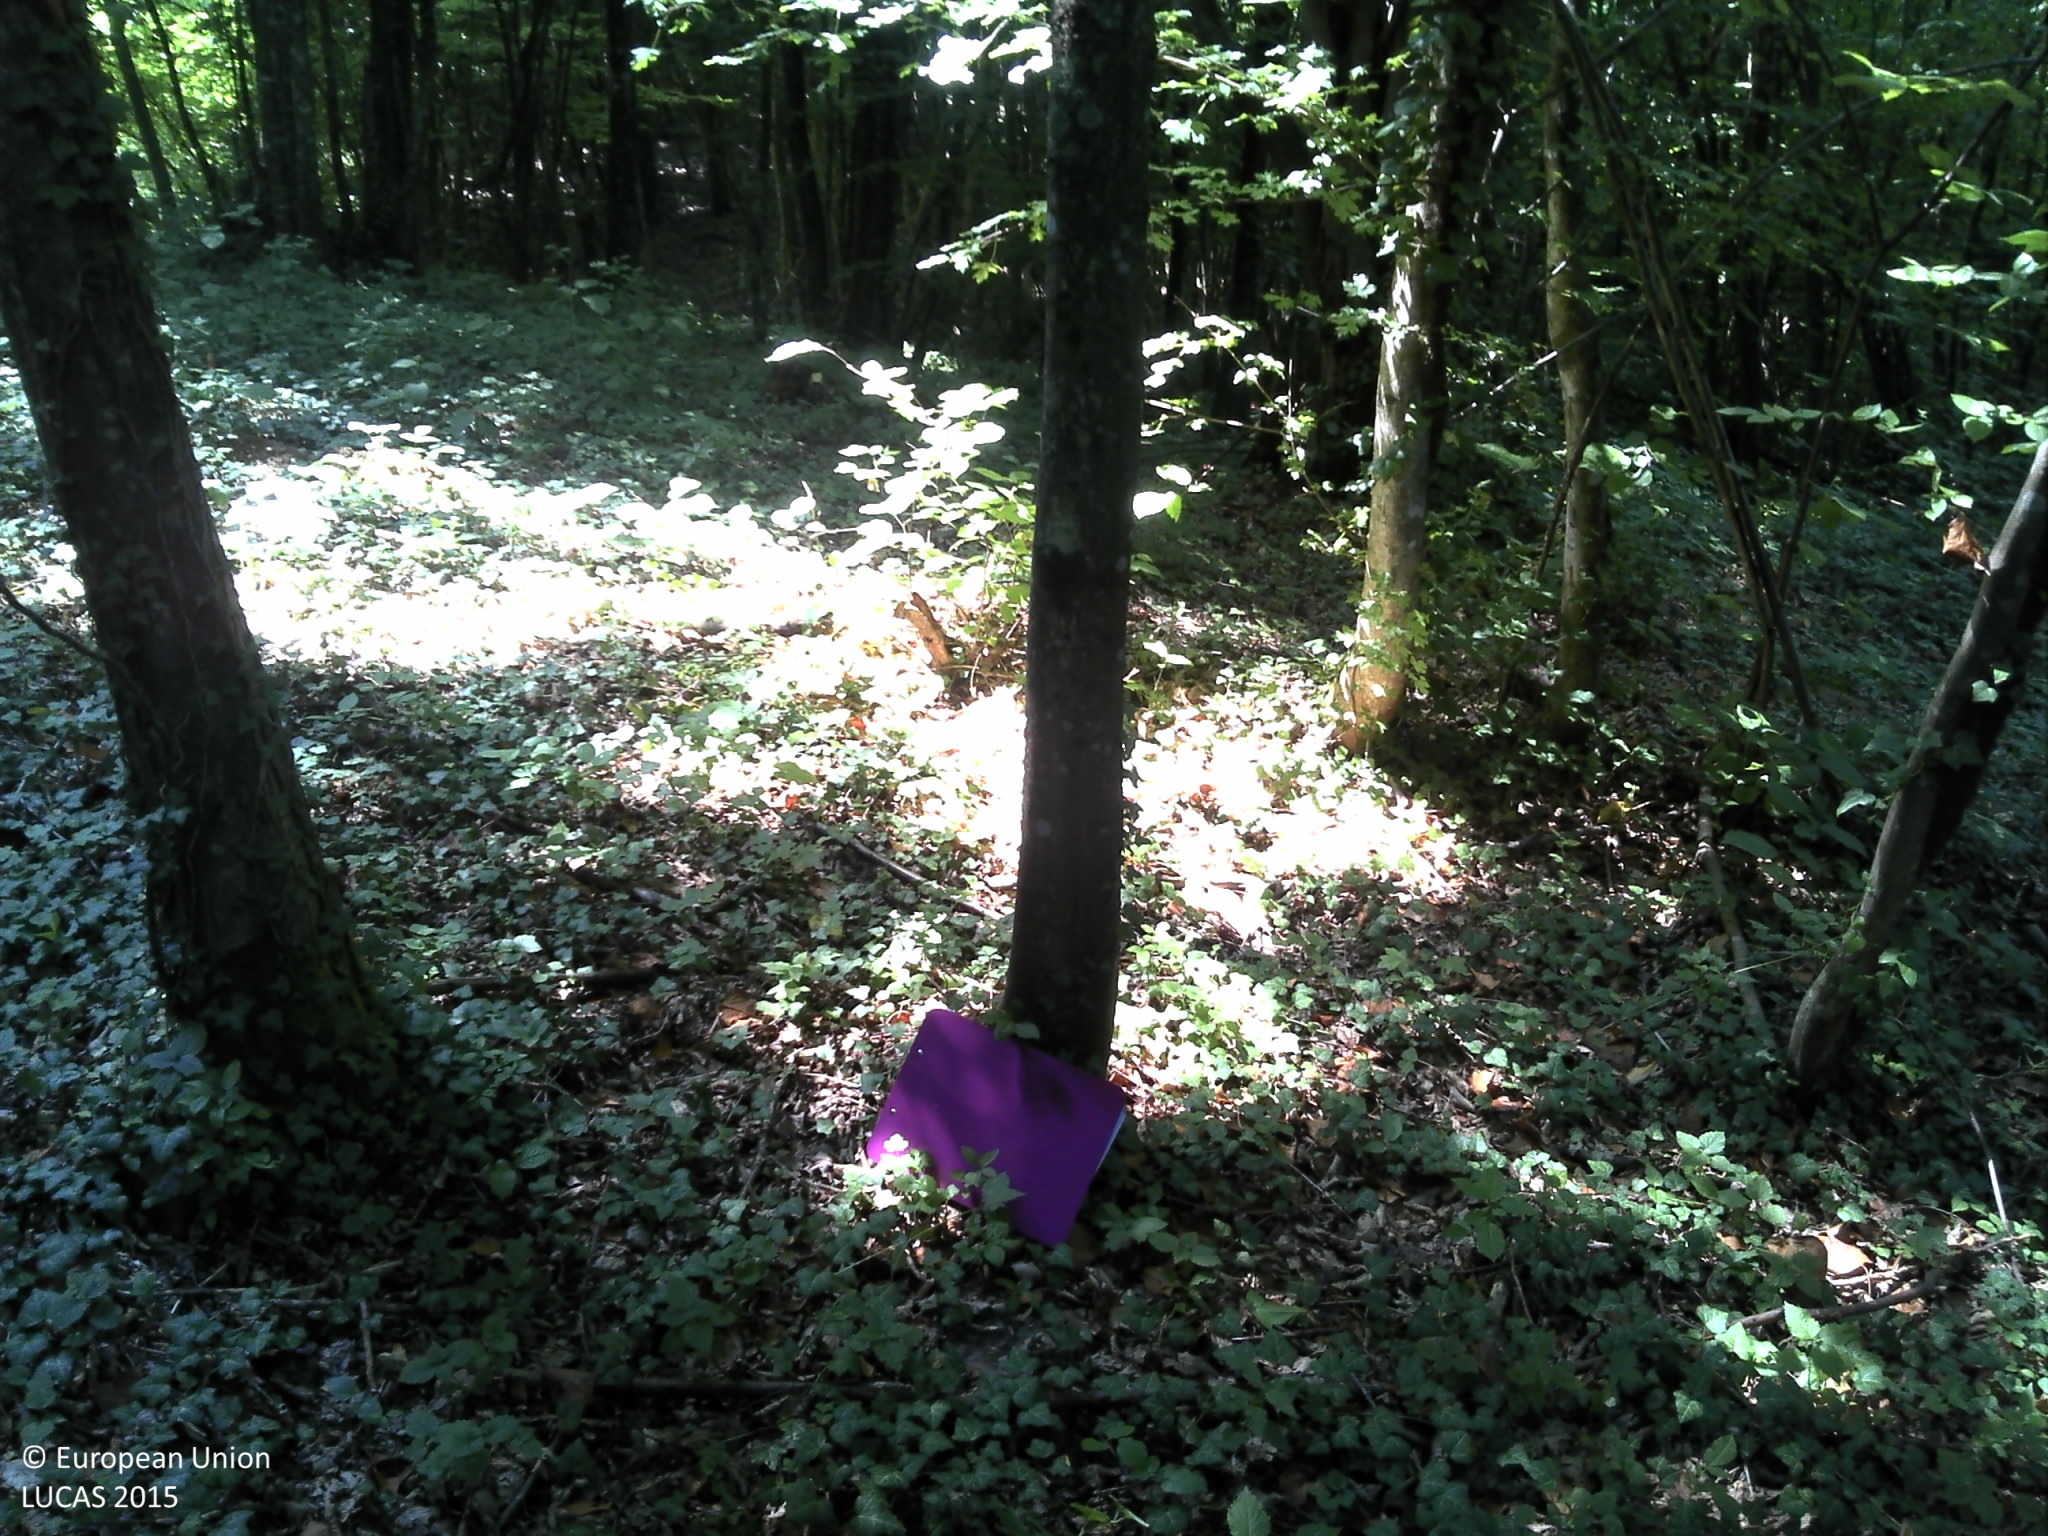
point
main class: Woodland
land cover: Broadleaved woodland
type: acidophilous oak and oak-birch forest
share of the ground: > 75 %
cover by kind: broadleaved forest trees 95 %, shrubs 5 %
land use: Forestry
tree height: > 5 m
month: June
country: HR
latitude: 45.2592
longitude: 17.9416
